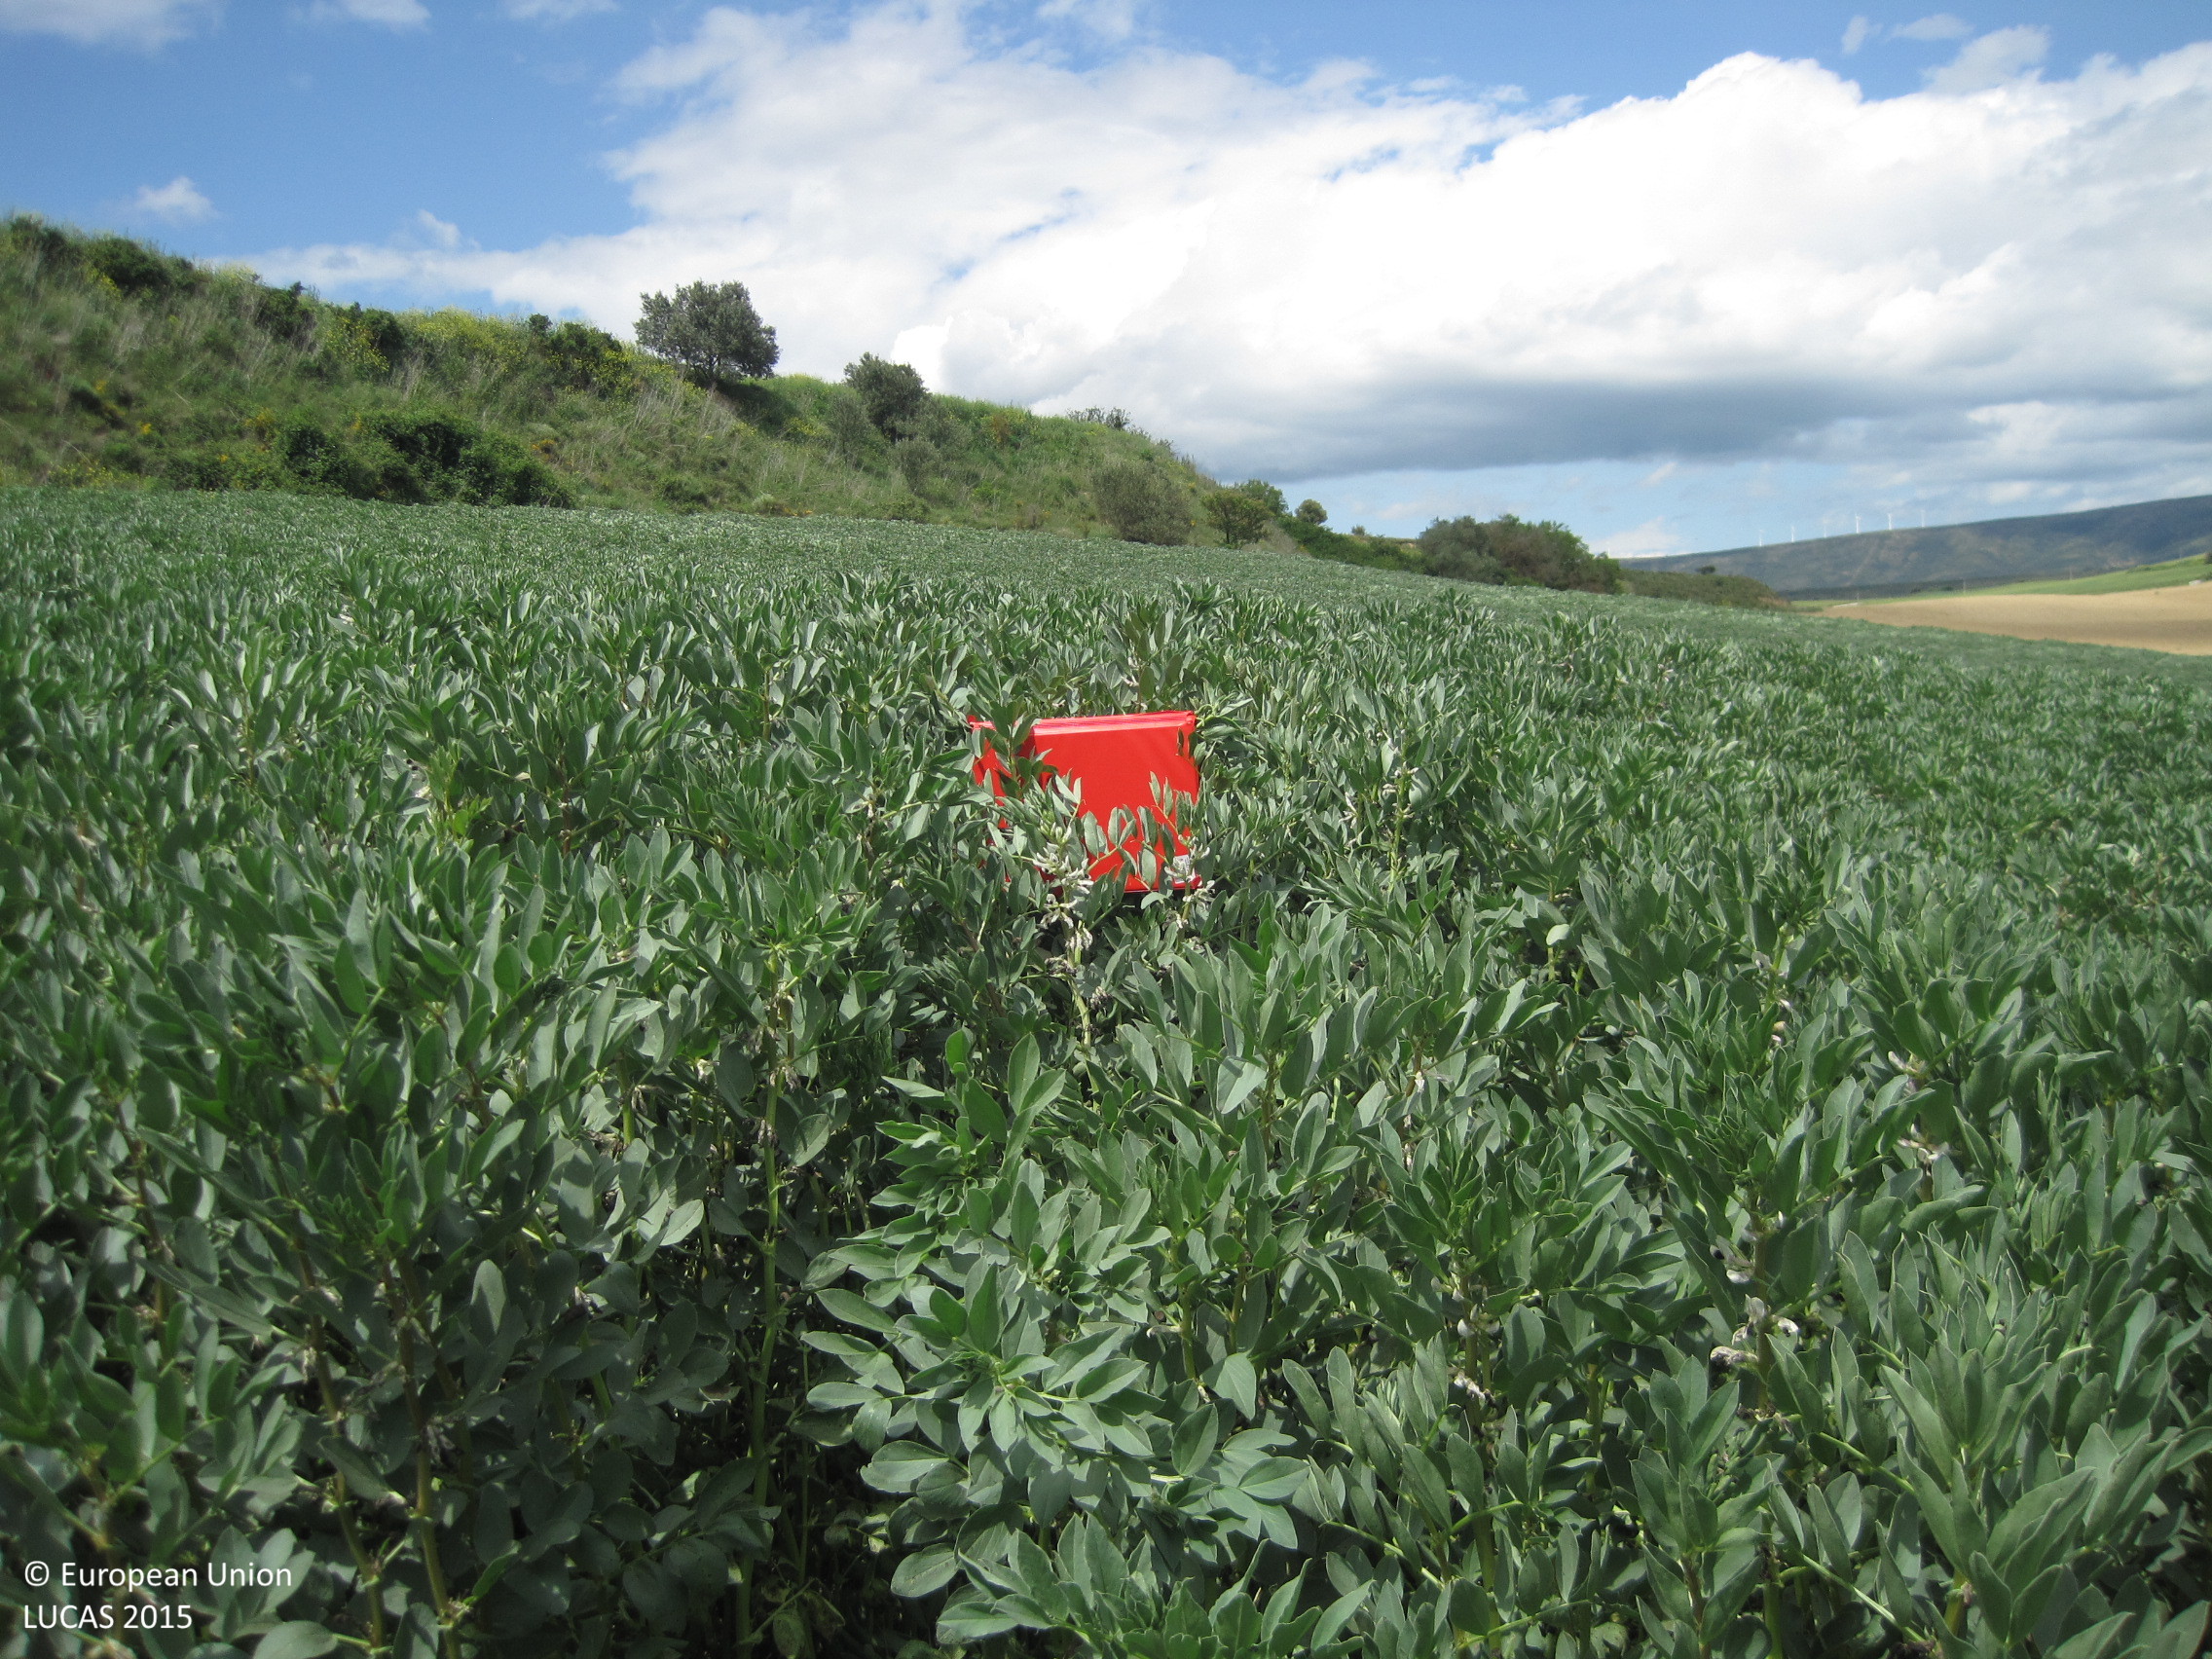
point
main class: Cropland
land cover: Dry pulses
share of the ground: > 75 %
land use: Agriculture (excluding fallow land and kitchen gardens)
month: May
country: ES
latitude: 42.6795
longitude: -1.7420
